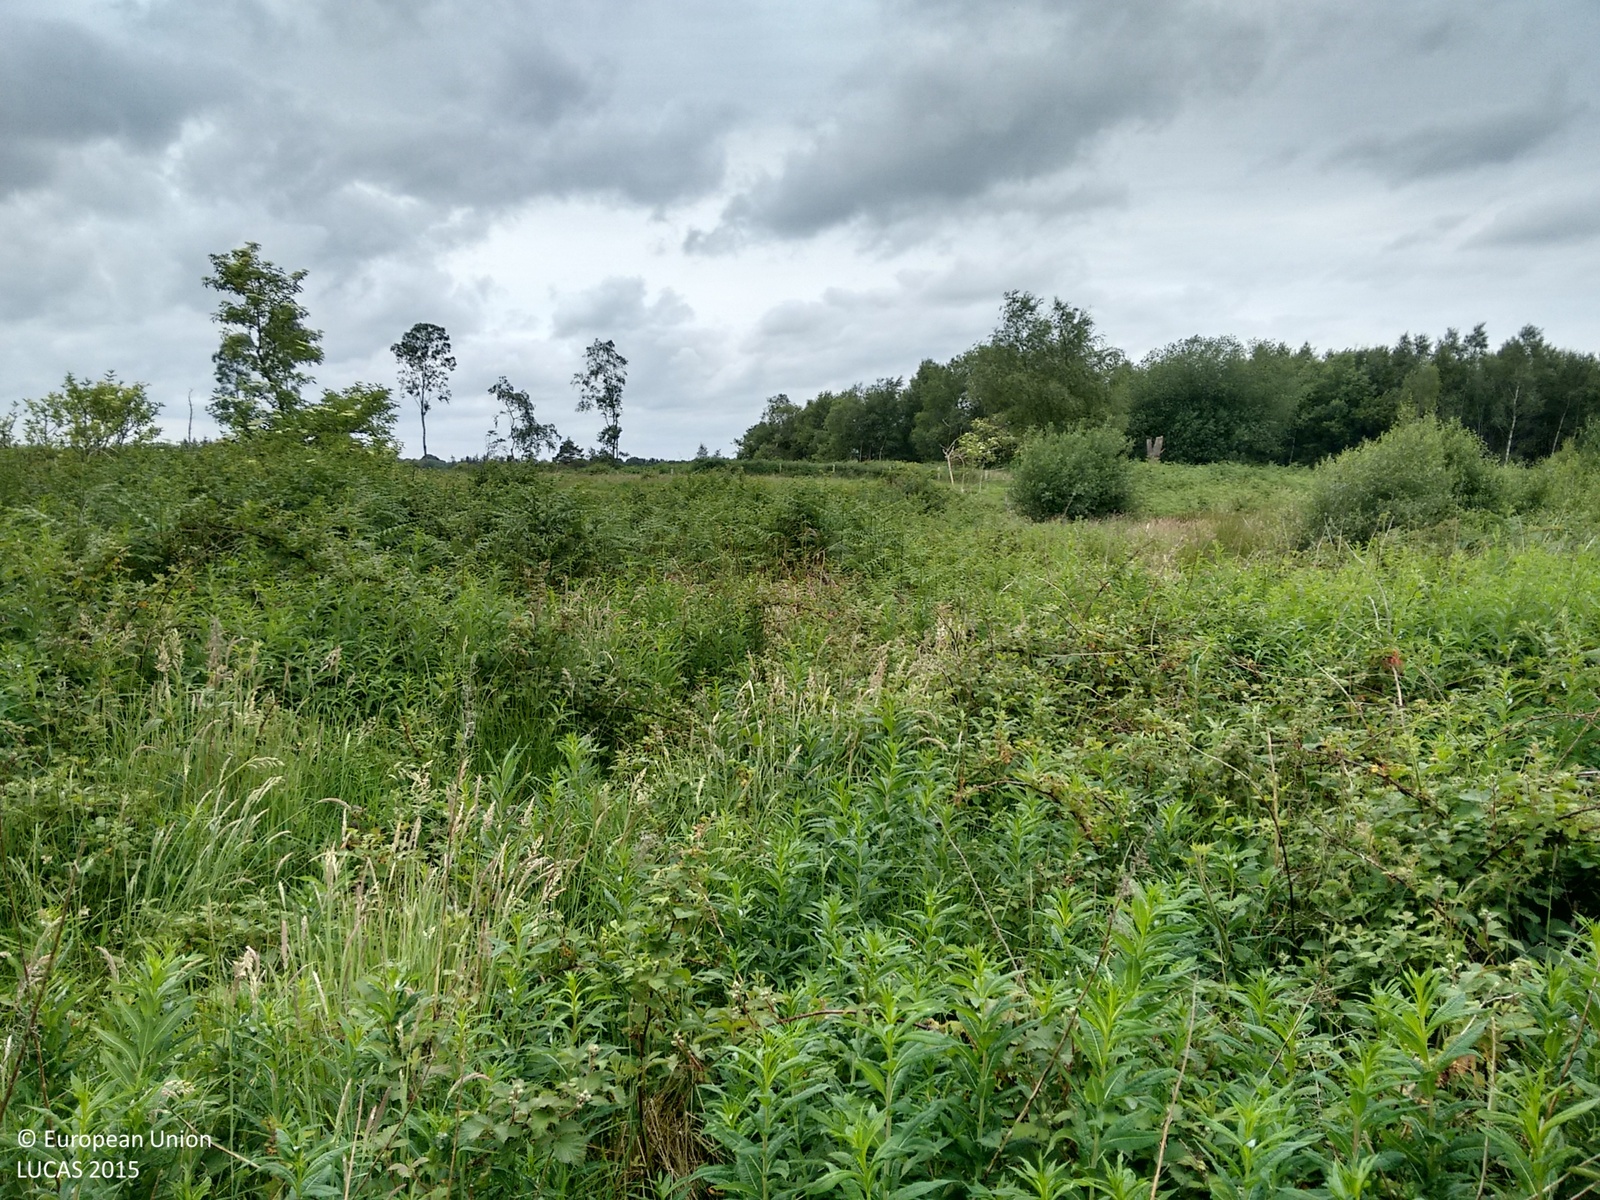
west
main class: Shrubland
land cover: Shrubland without tree cover
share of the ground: > 75 %
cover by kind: herbaceous plants 80 %, shrubs 20 %
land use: Forestry
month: June
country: IE
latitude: 53.7468
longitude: -6.7689
